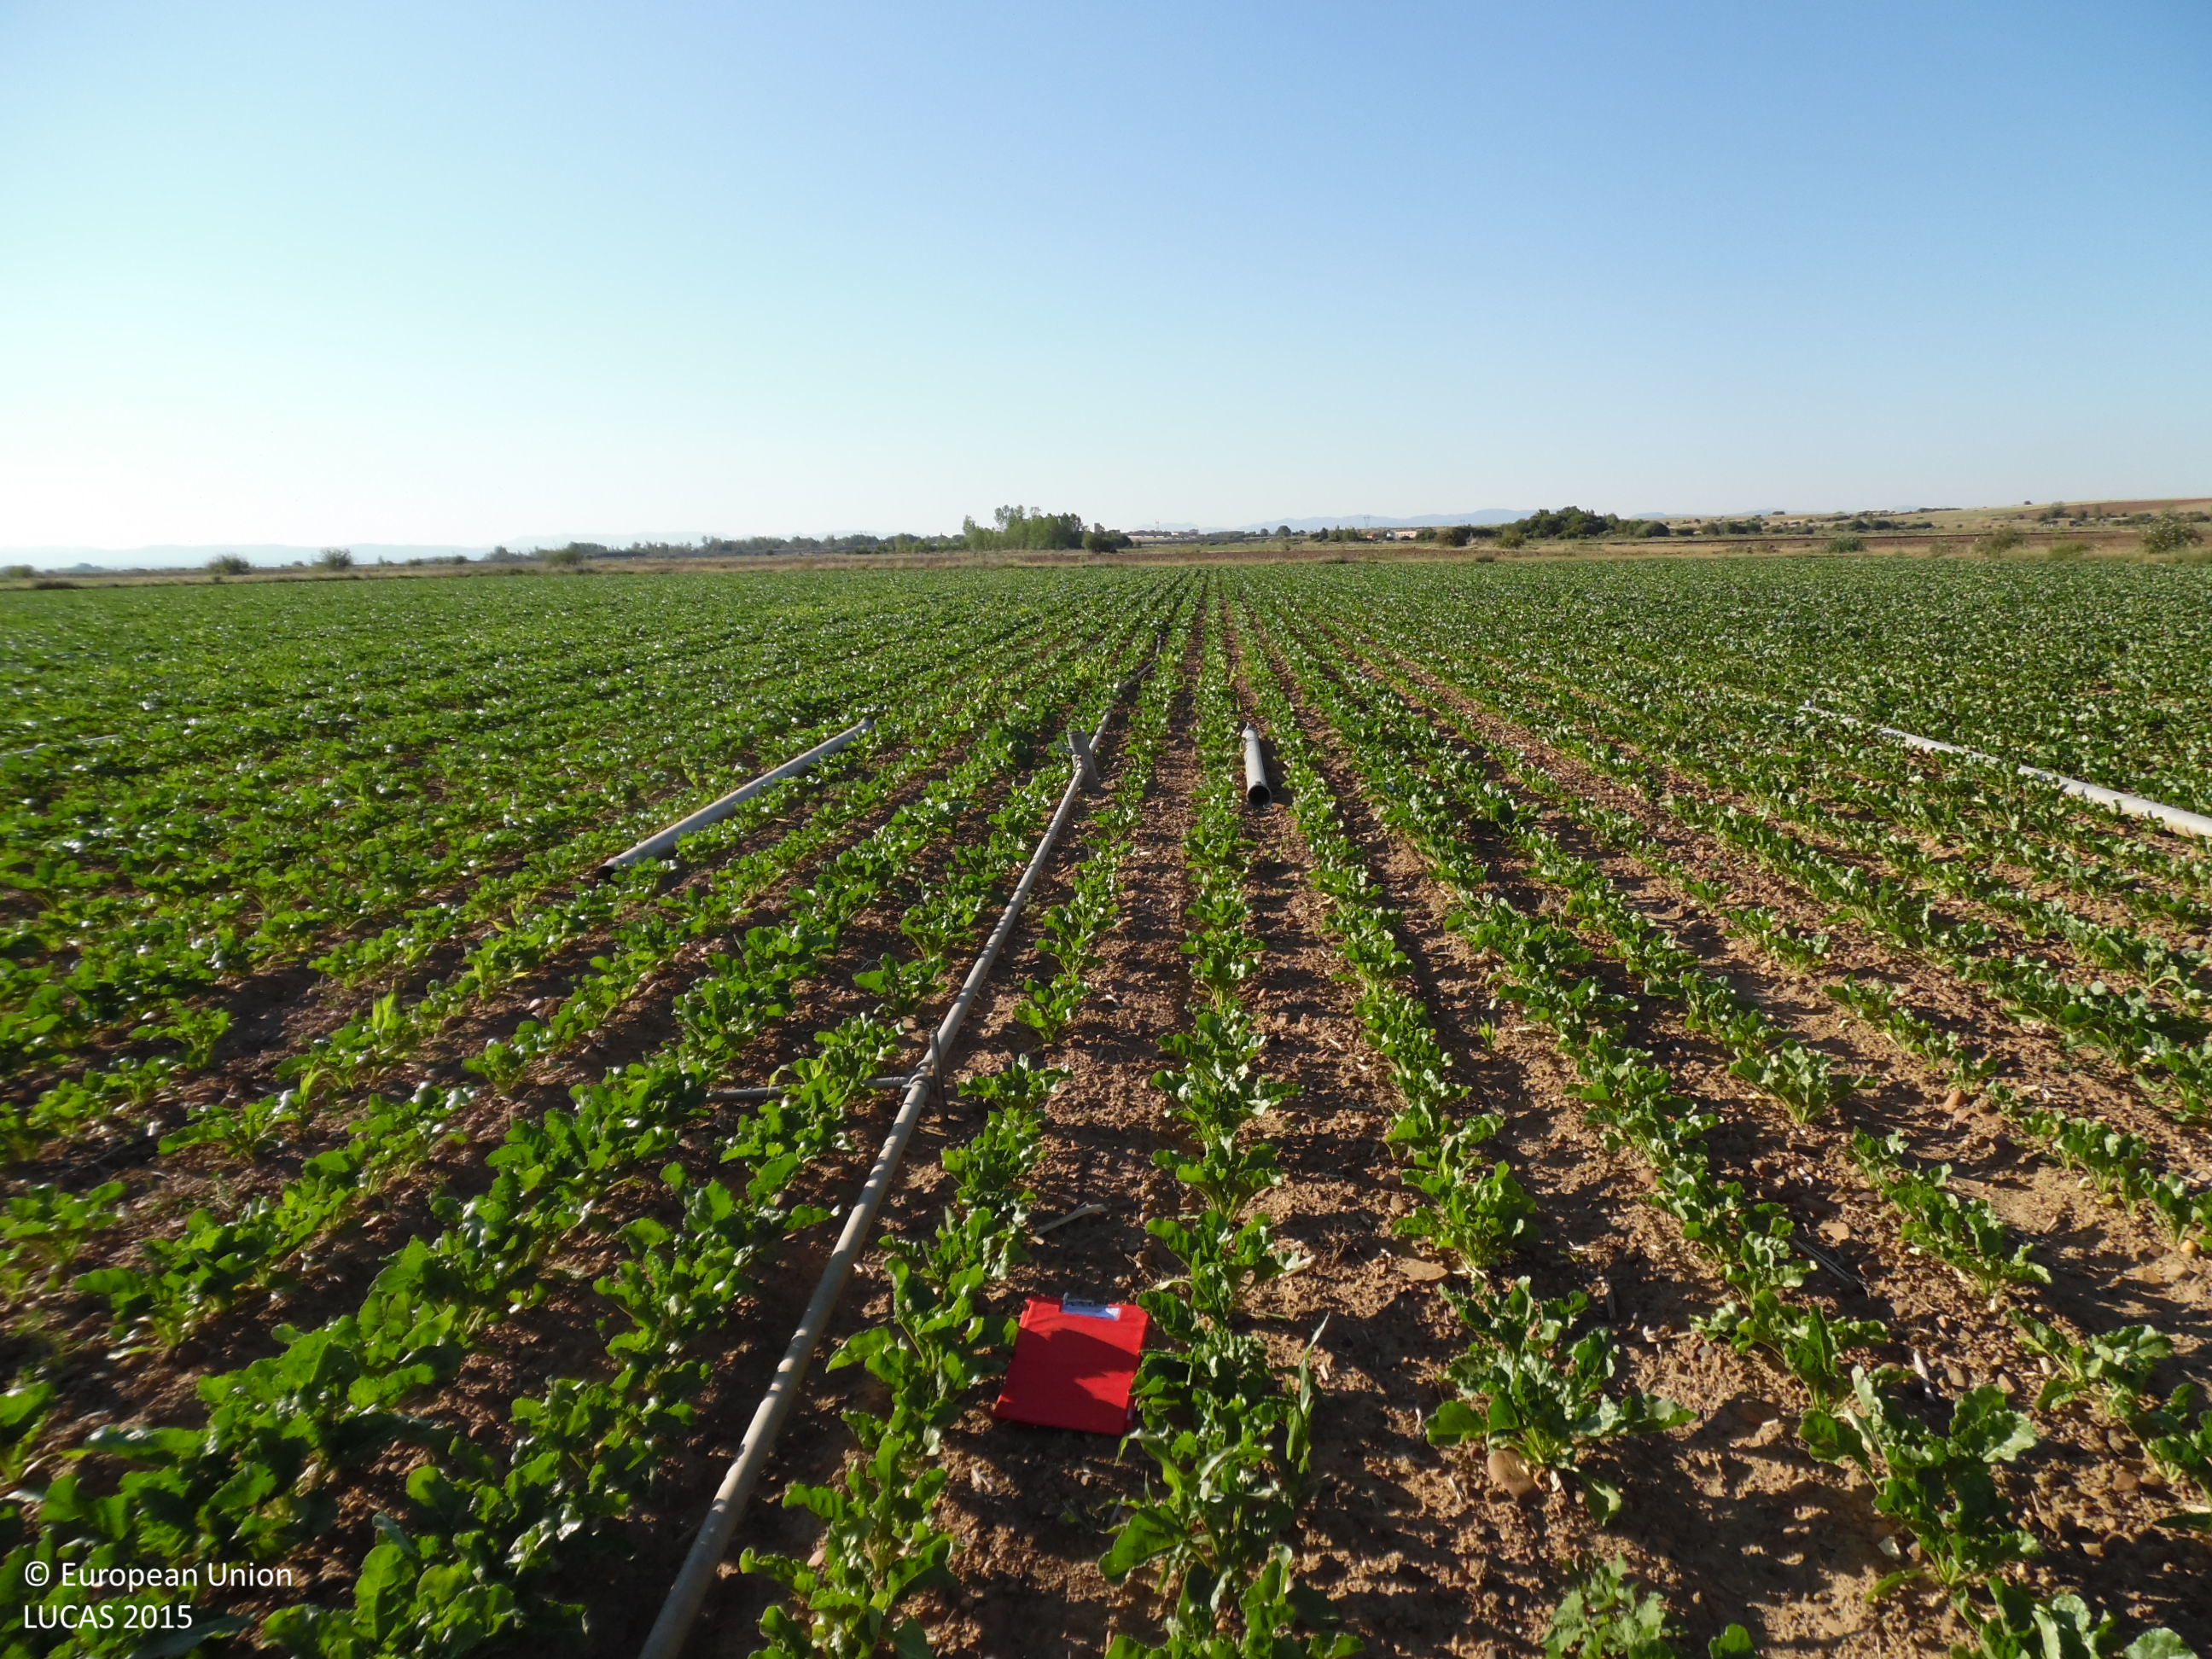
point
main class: Cropland
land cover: Sugar beet
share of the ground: > 75 %
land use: Agriculture (excluding fallow land and kitchen gardens)
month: June
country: ES
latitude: 42.4948
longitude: -5.7594
